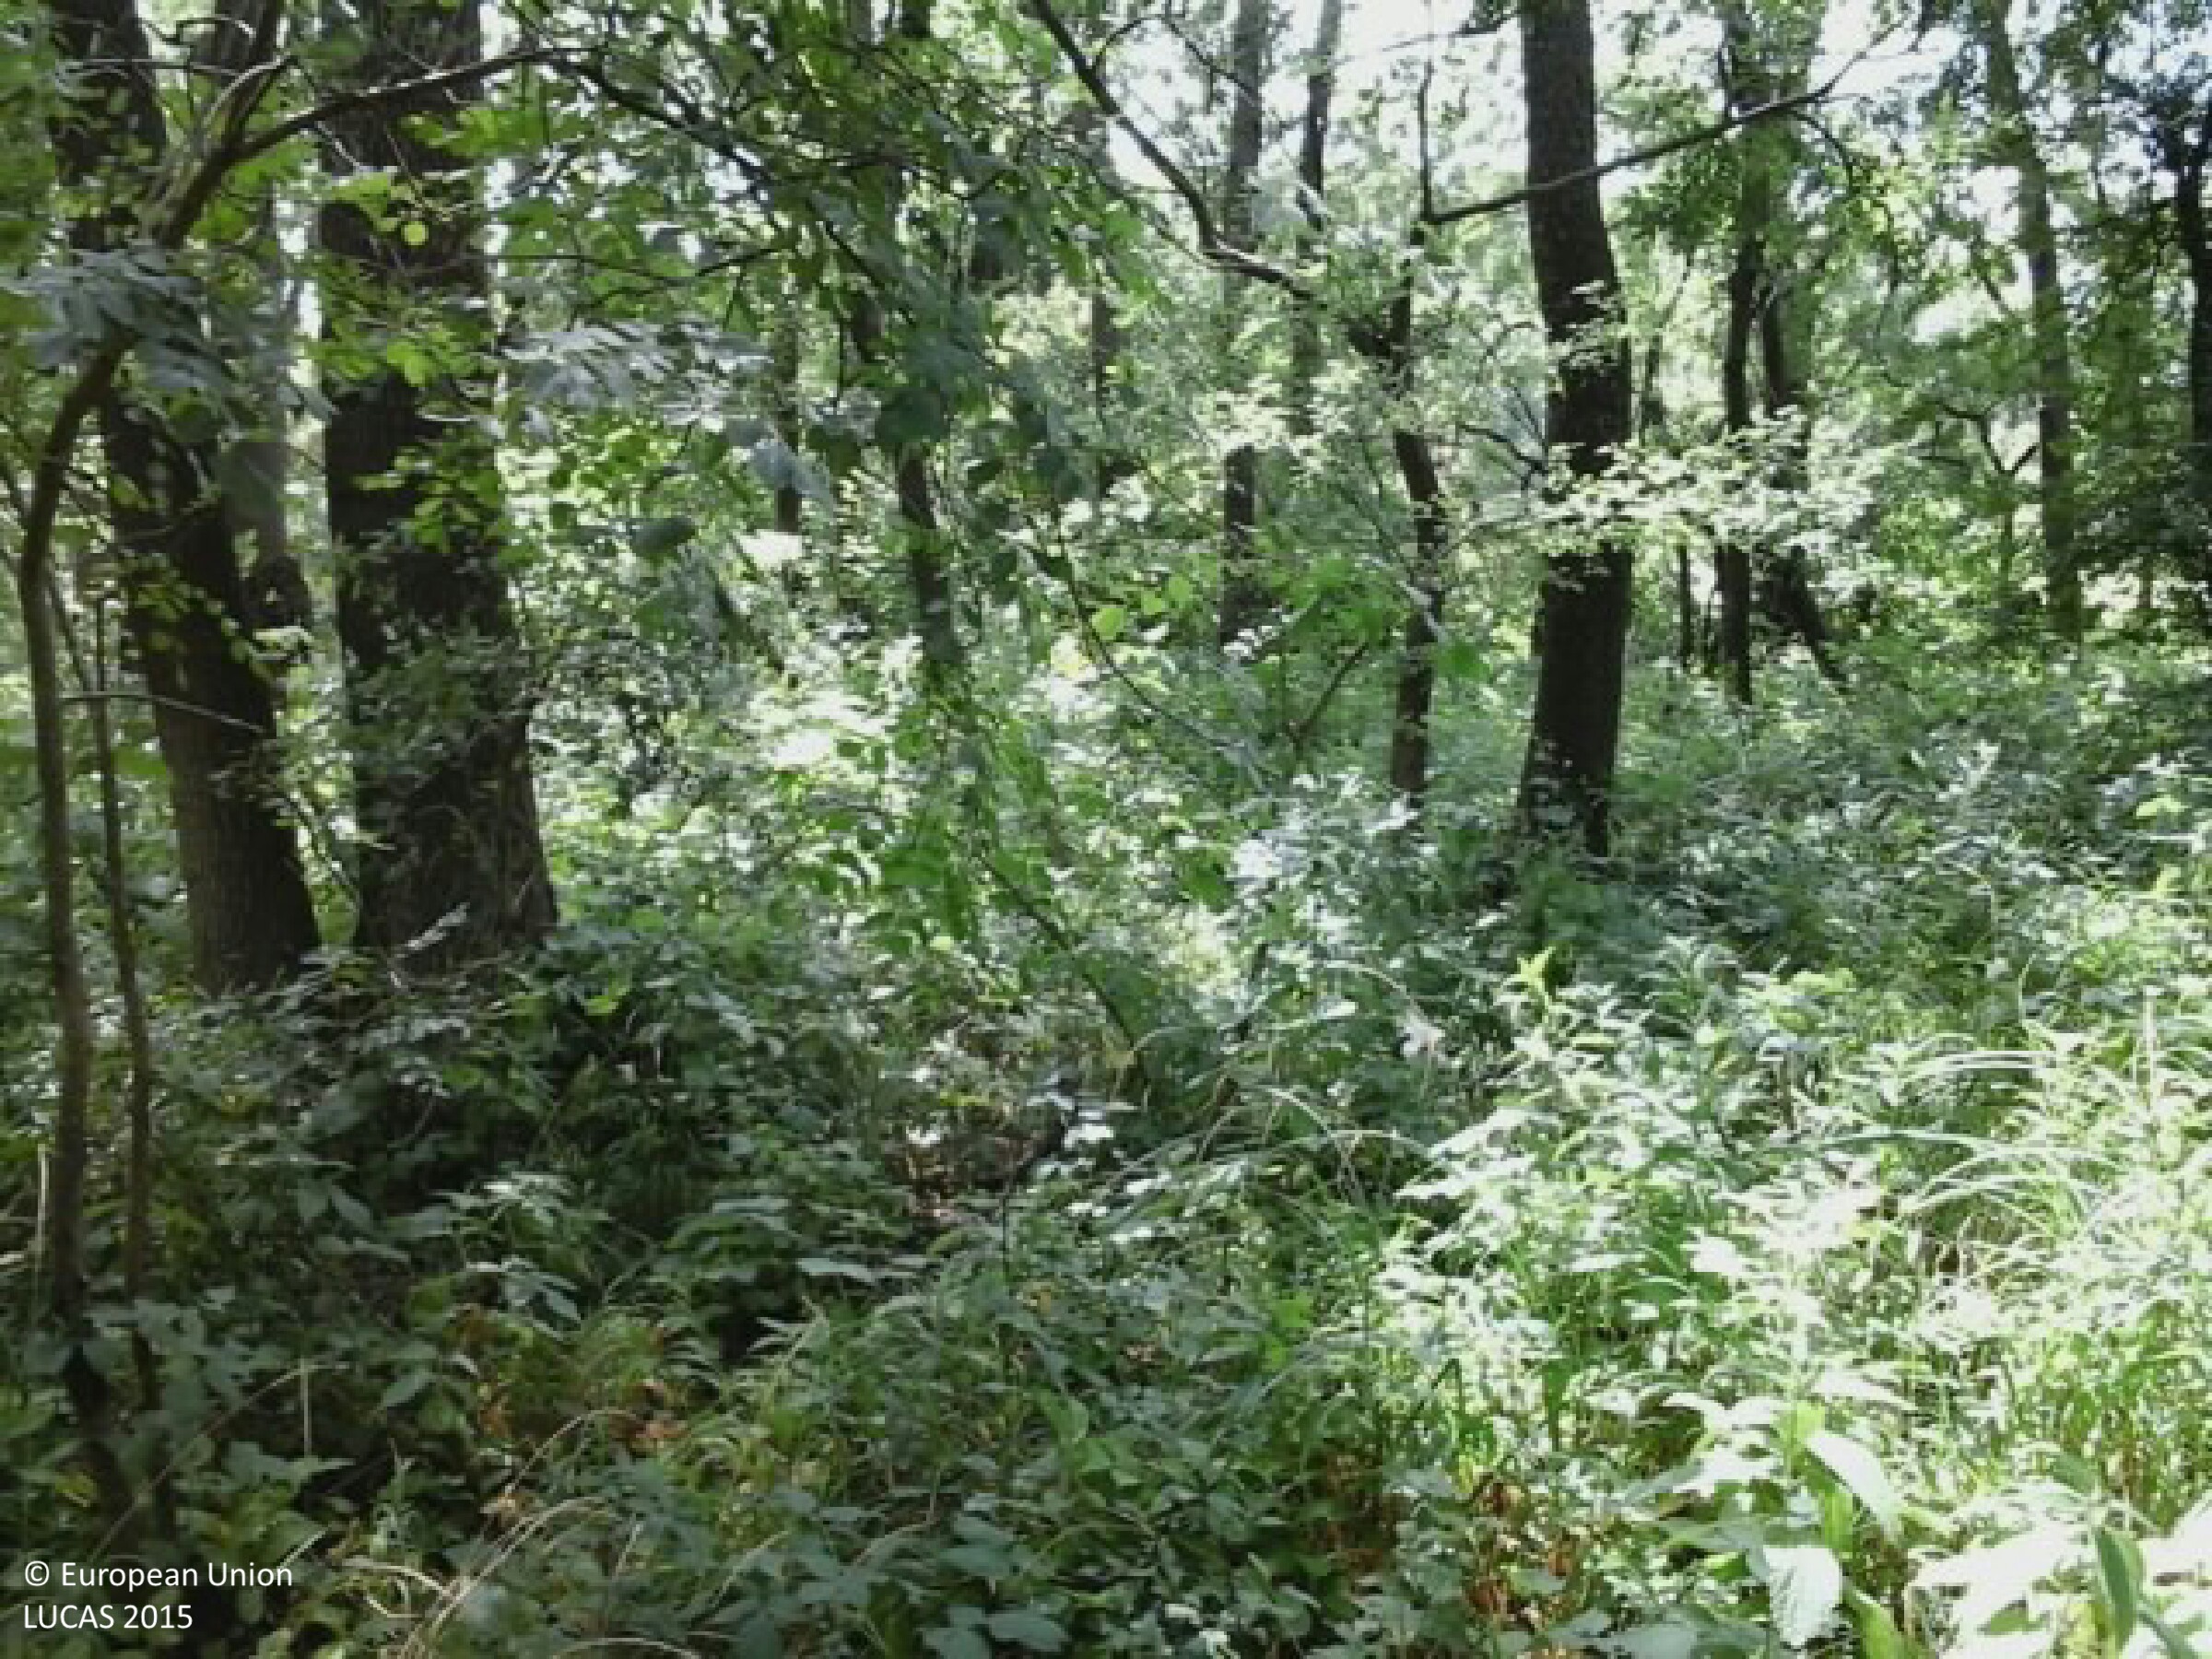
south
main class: Woodland
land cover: Broadleaved woodland
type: thermophilous deciduous forest
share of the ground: > 75 %
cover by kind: broadleaved forest trees 85 %, shrubs 10 %, herbaceous plants 5 %
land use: Forestry
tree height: > 5 m
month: July
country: HU
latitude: 47.2539
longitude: 19.2549
